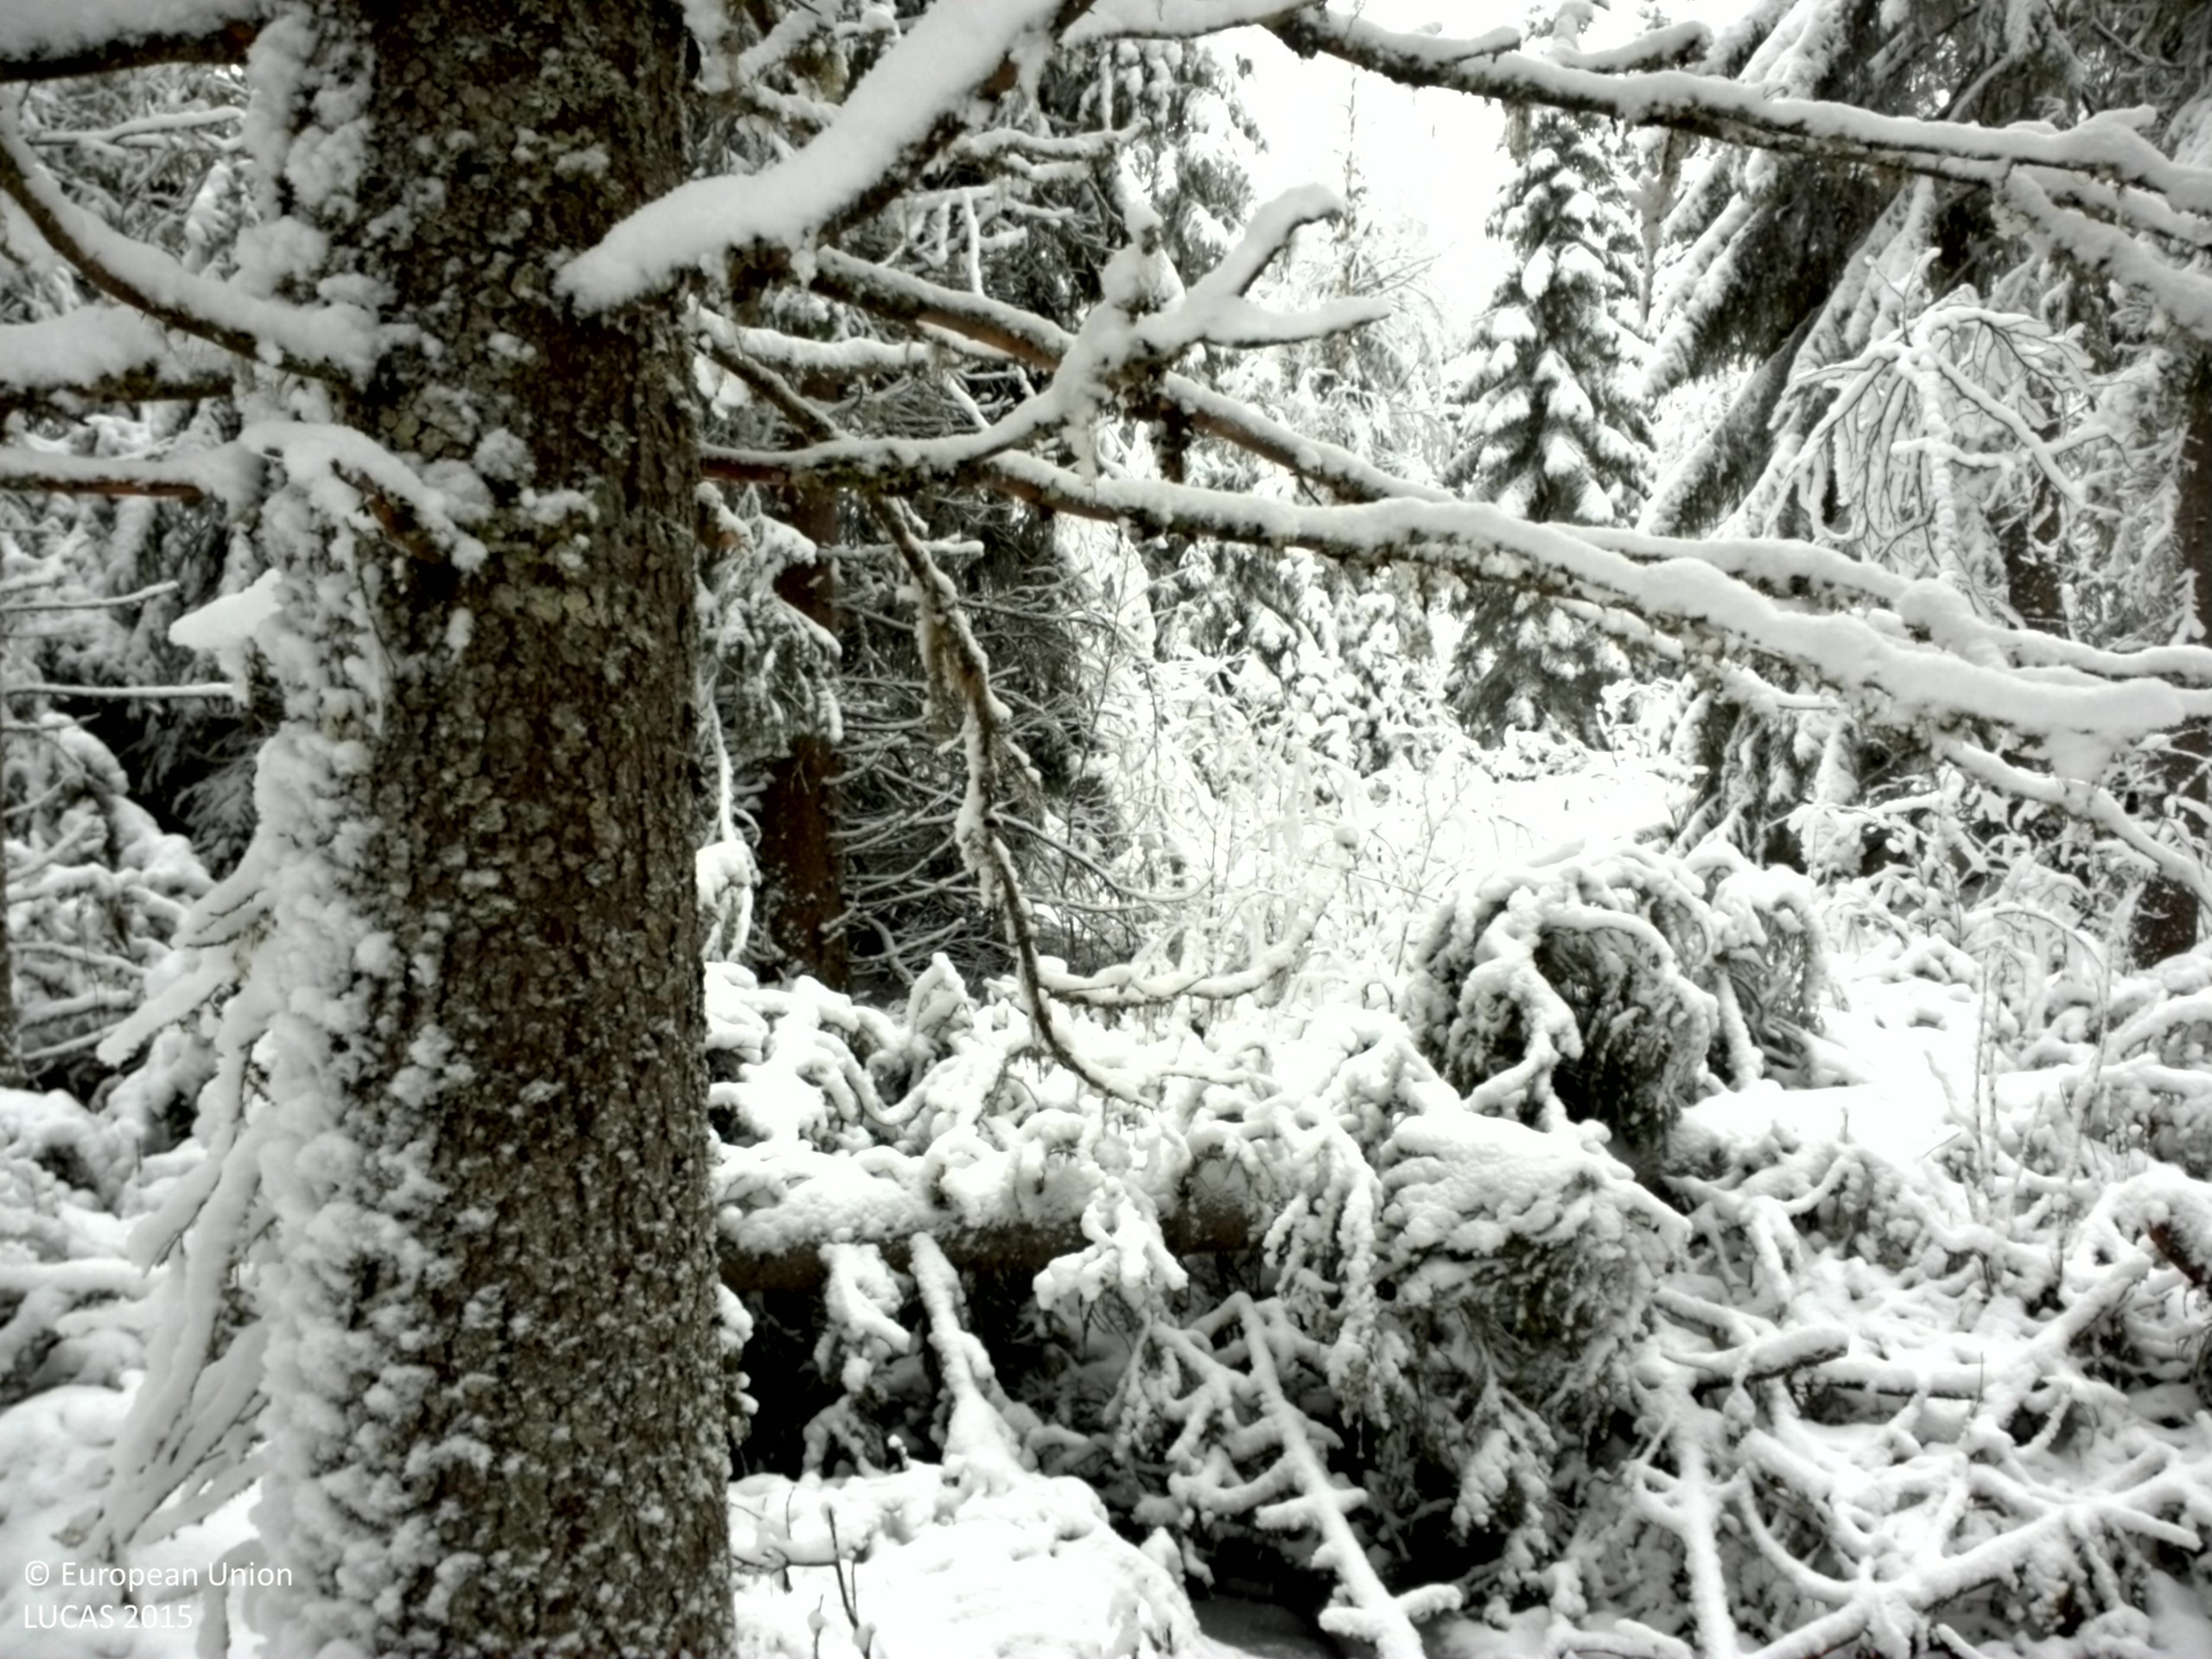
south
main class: Woodland
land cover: Spruce dominated coniferous woodland
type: boreal forest
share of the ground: > 75 %
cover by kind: coniferous forest trees 70 %, shrubs 15 %, lichens and mosses 10 %, broadleaved forest trees 5 %
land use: Forestry
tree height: > 5 m
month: November
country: SE
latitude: 63.7430
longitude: 15.4645
